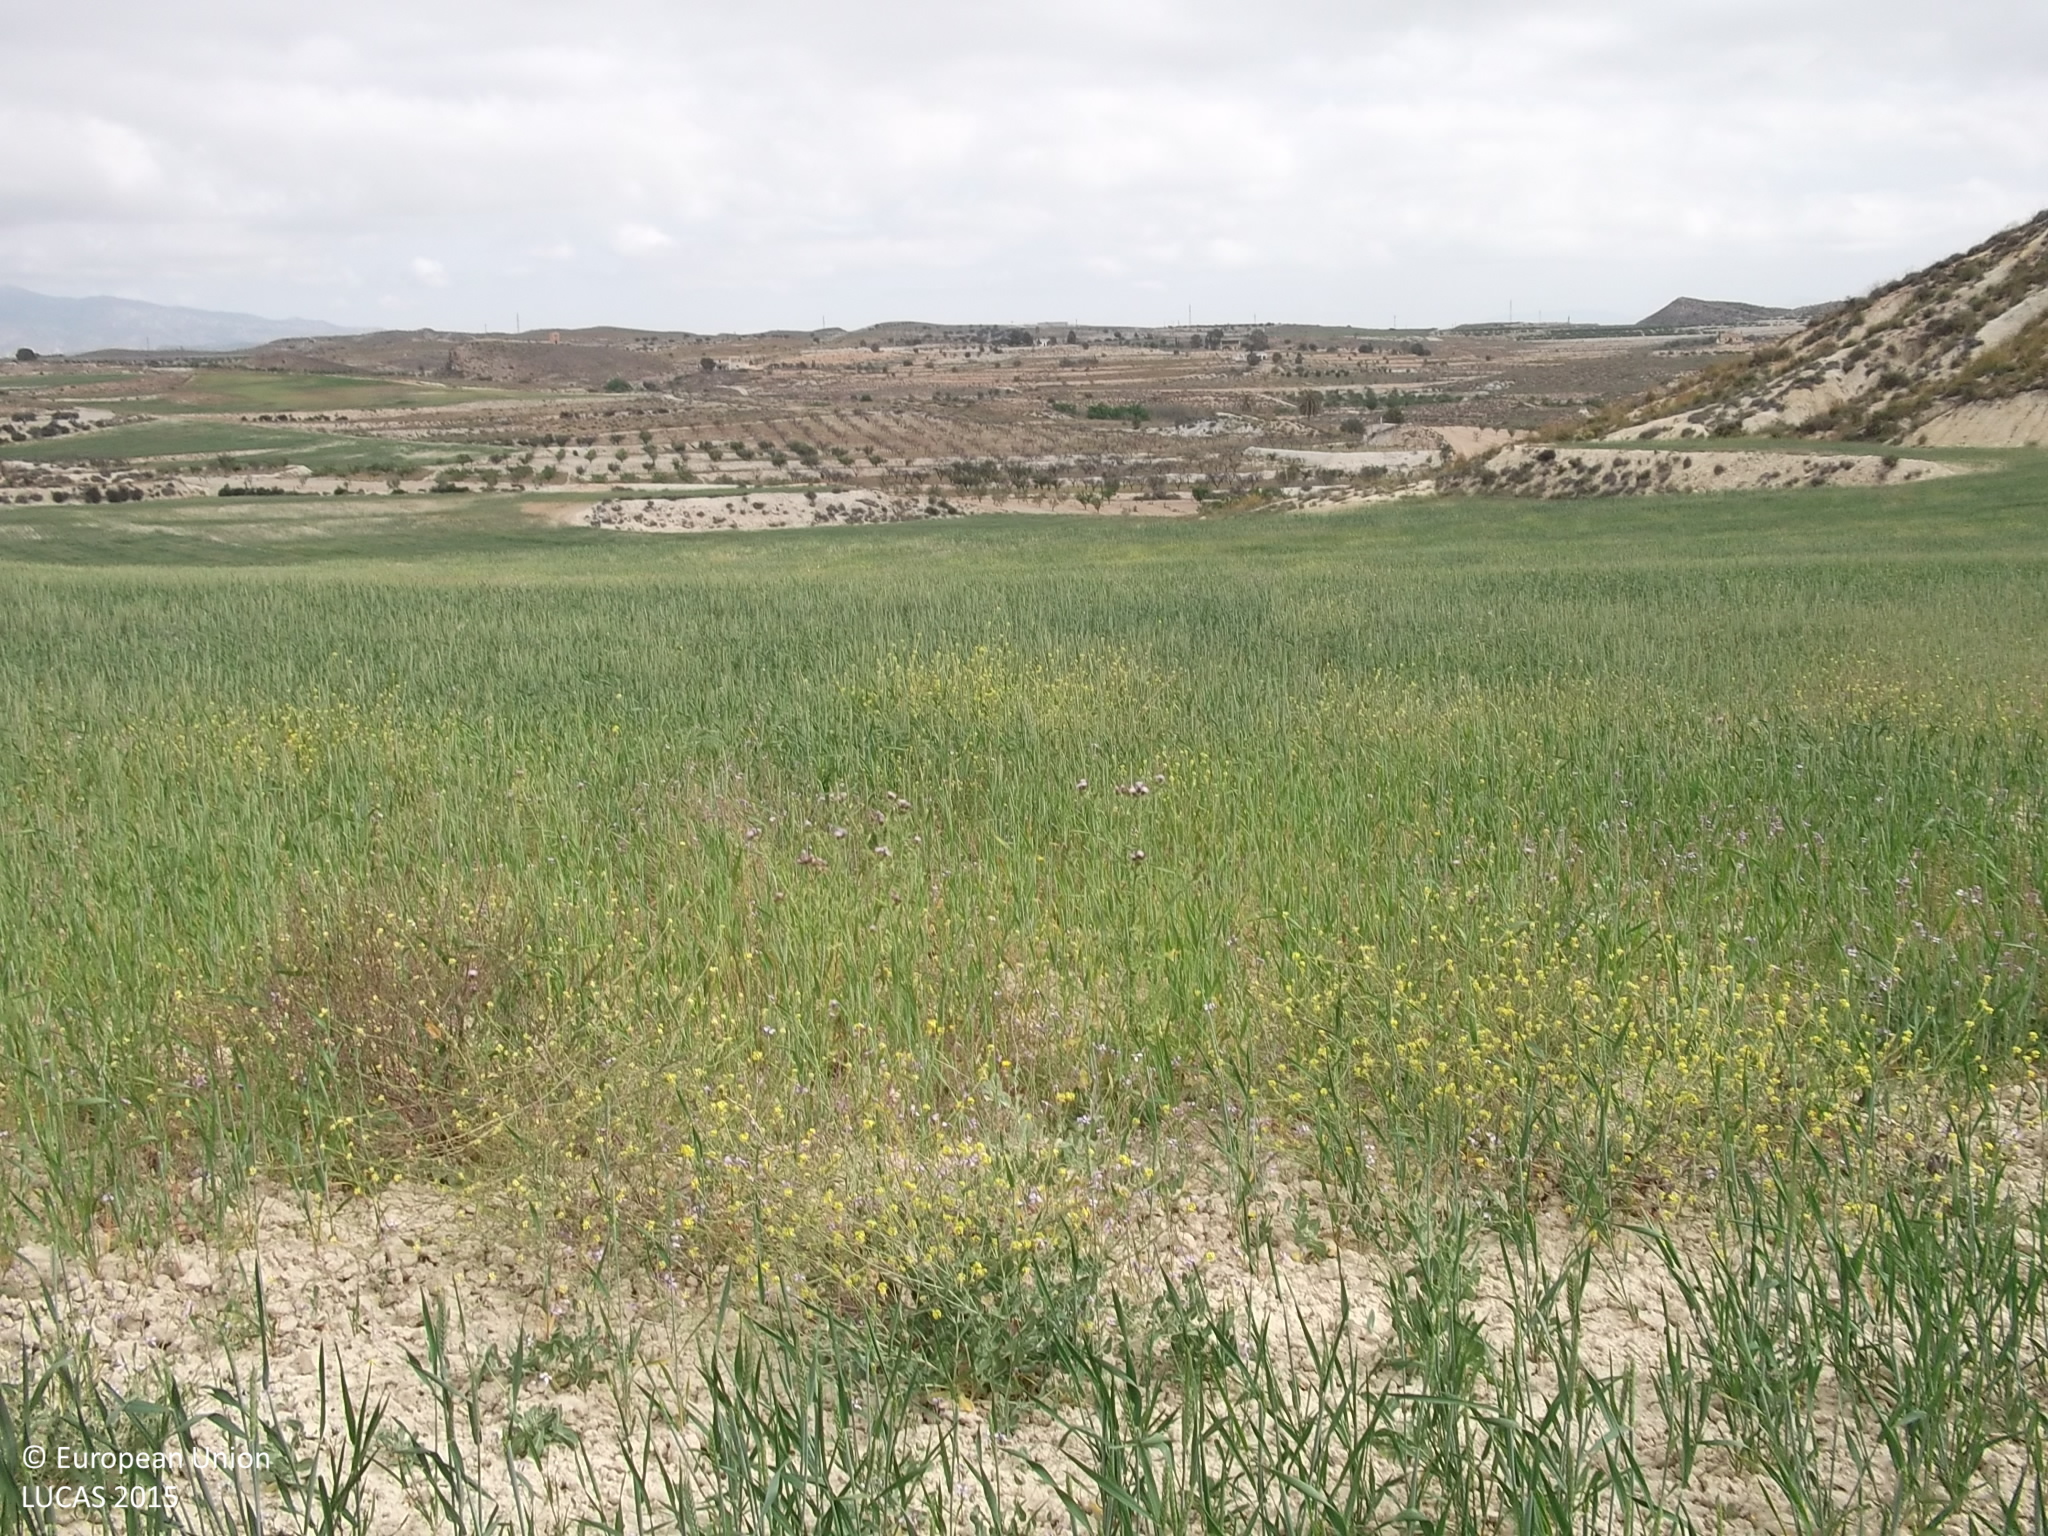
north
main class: Cropland
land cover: Common wheat
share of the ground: > 75 %
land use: Agriculture (excluding fallow land and kitchen gardens)
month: April
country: ES
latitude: 37.9973
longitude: -1.3612
